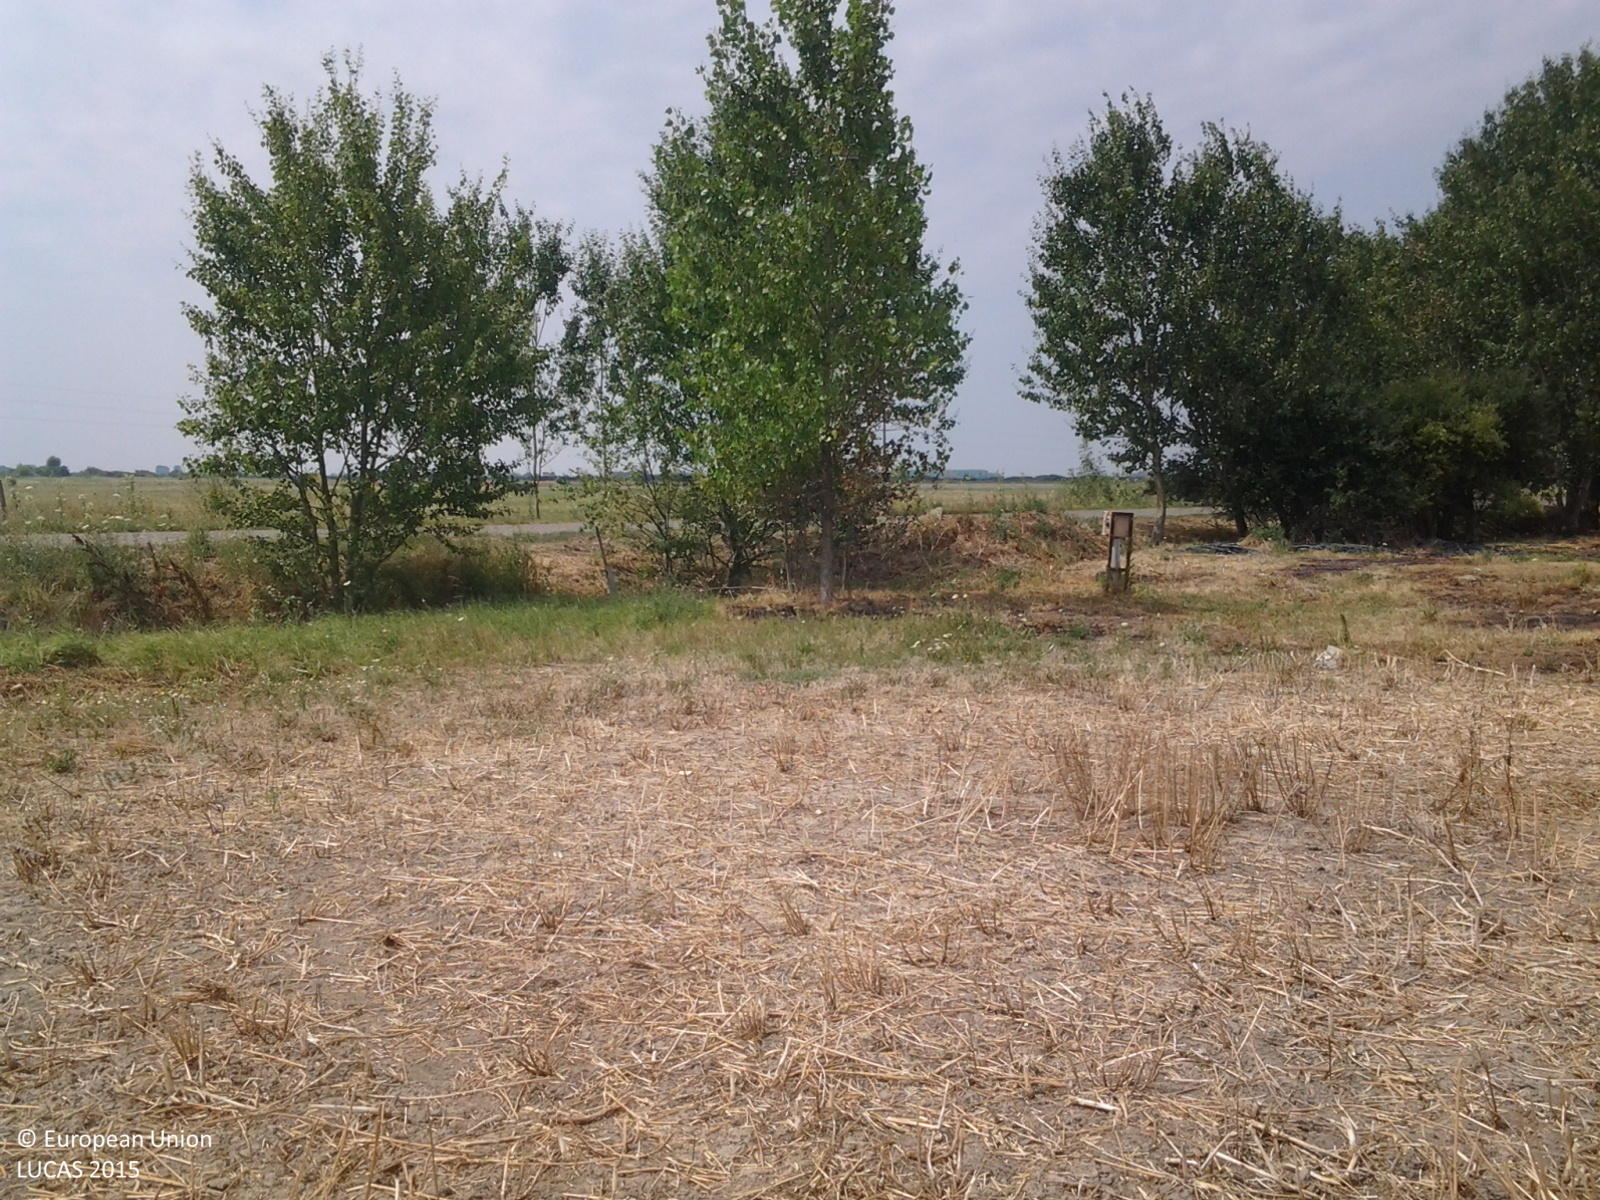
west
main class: Cropland
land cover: Rape and turnip rape
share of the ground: < 10 %
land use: Agriculture (excluding fallow land and kitchen gardens)
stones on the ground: < 10 %
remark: Harvested field
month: July
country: HU
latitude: 46.7683
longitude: 21.4705
